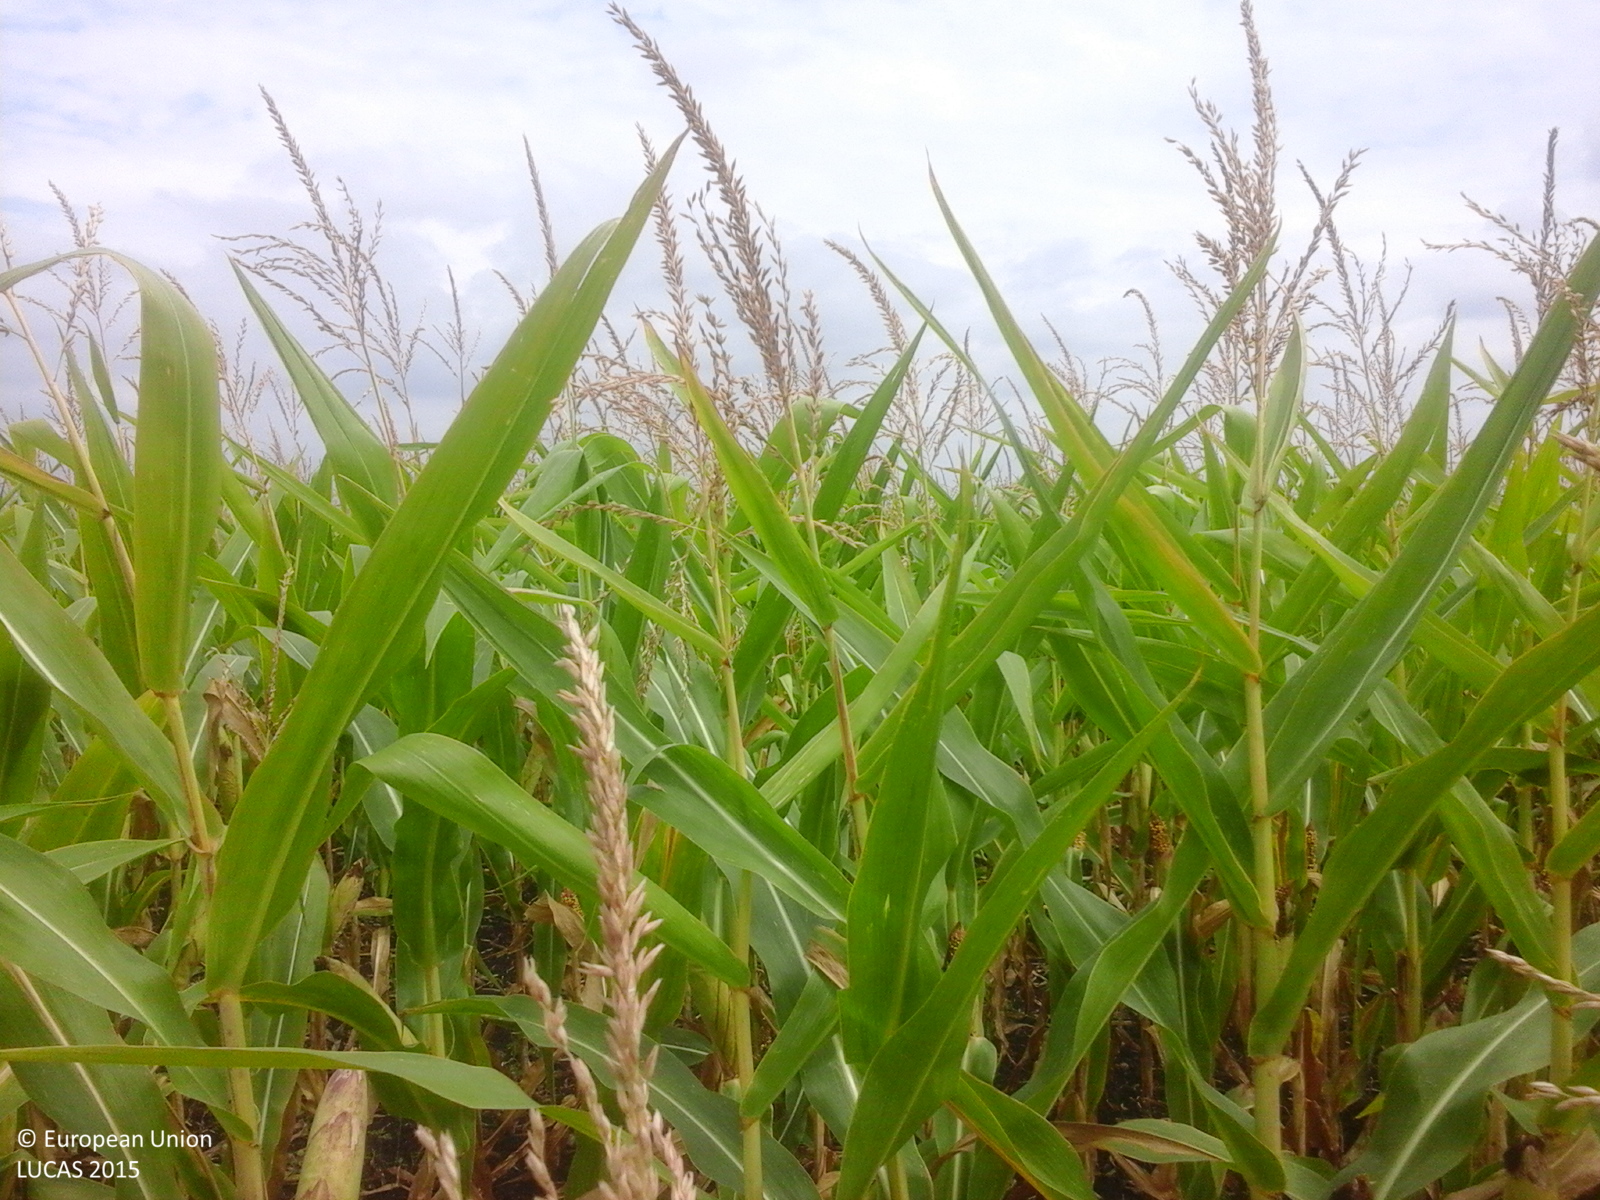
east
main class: Cropland
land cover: Maize
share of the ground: > 75 %
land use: Agriculture (excluding fallow land and kitchen gardens)
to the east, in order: Maize; Sunflower
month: August
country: RO
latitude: 45.4776
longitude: 21.3001
